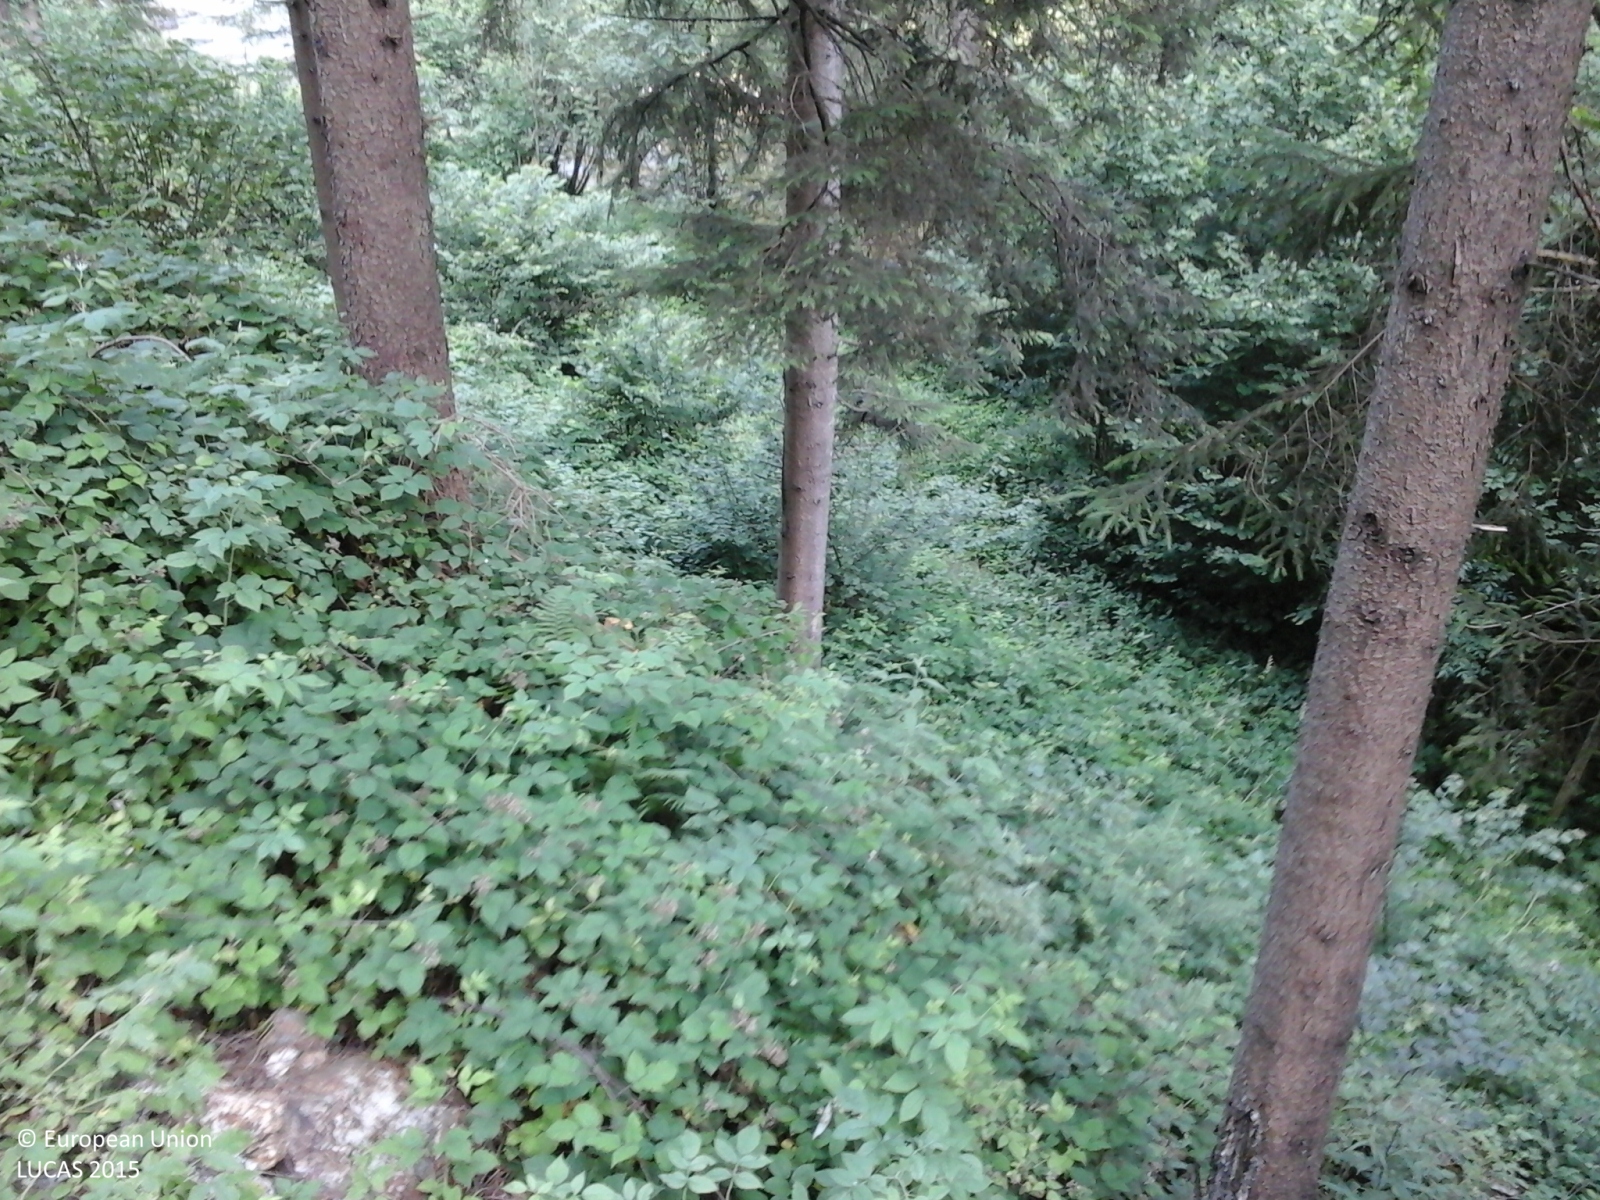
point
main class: Woodland
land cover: Spruce dominated coniferous woodland
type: alpine coniferous forest
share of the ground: > 75 %
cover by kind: coniferous forest trees 80 %, broadleaved forest trees 20 %
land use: Semi-natural and natural areas not in use
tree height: > 5 m
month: July
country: IT
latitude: 45.9729
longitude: 9.9356
